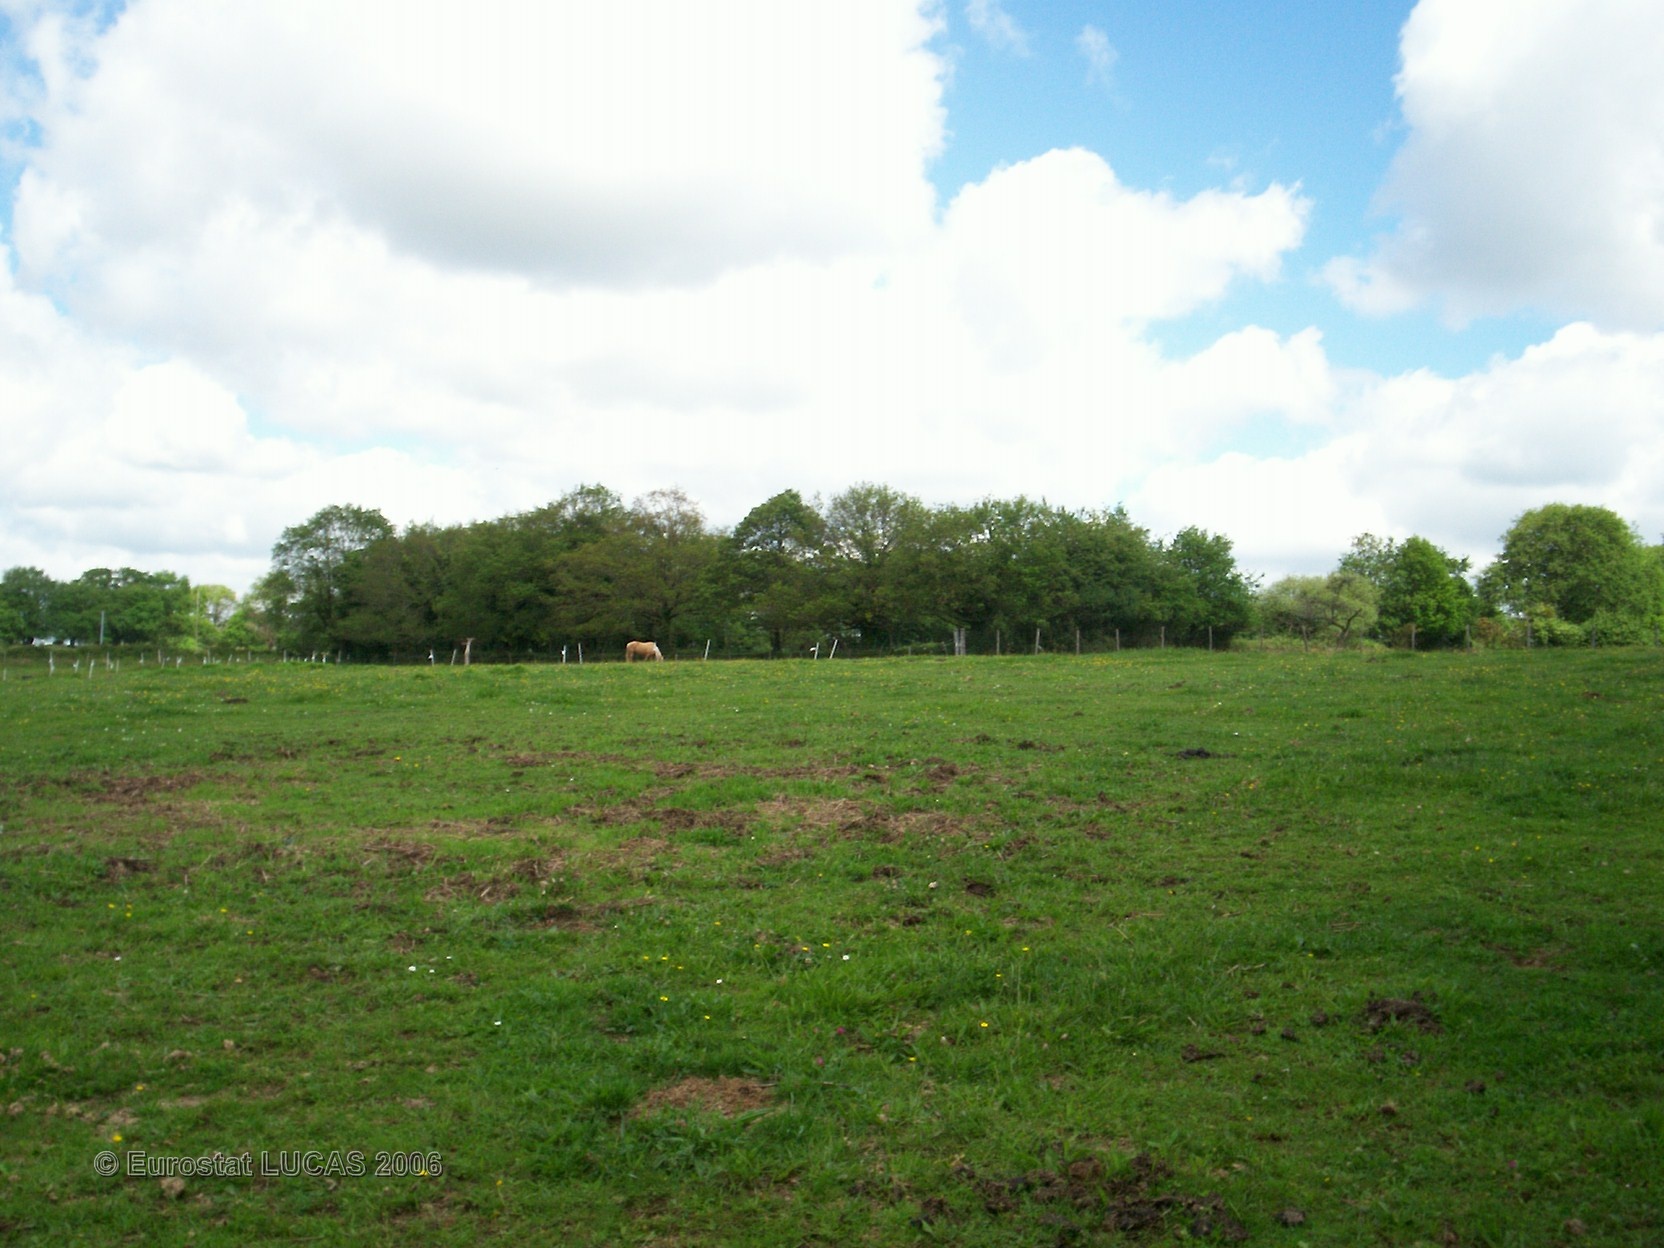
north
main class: Grassland
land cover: Grassland without tree/shrub cover
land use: Agriculture (excluding fallow land and kitchen gardens)
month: May
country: FR
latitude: 47.7292
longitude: -2.7961
